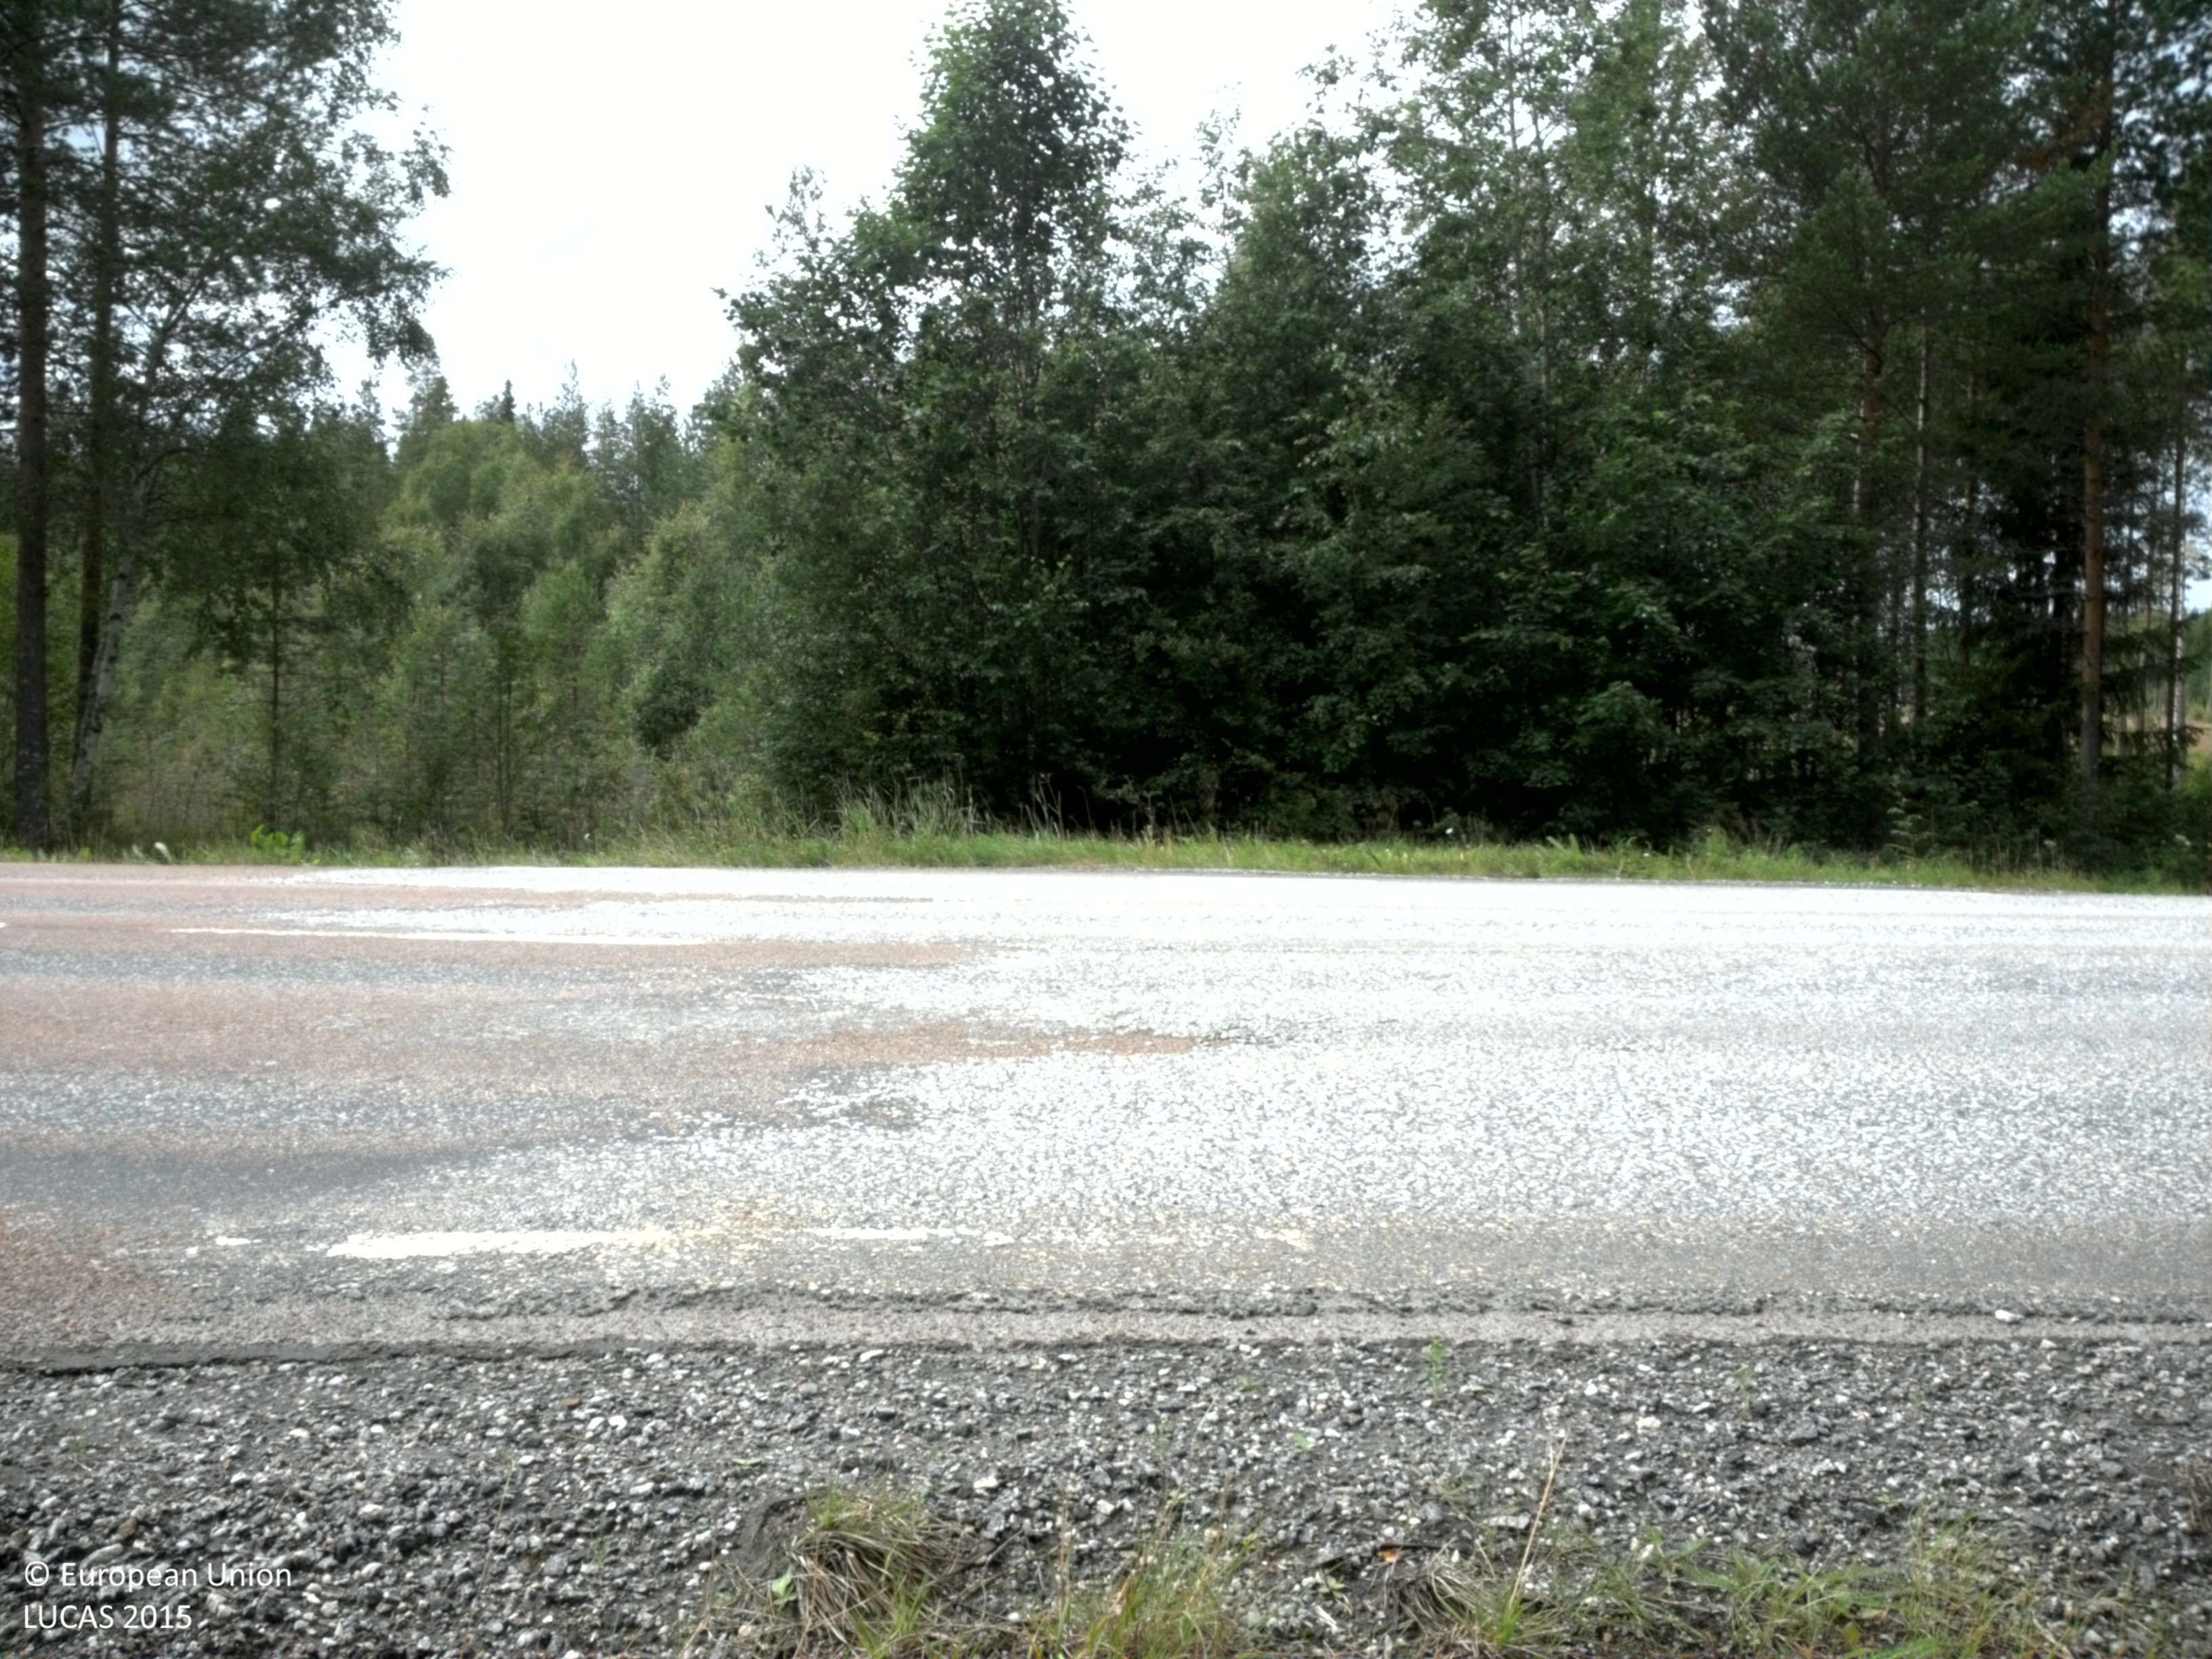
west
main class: Woodland
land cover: Spruce dominated mixed woodland
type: boreal forest
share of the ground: 50 - 75 %
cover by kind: coniferous forest trees 45 %, shrubs 25 %, broadleaved forest trees 15 %, herbaceous plants 10 %, lichens and mosses 5 %
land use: Forestry
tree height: > 5 m
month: August
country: SE
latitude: 64.6207
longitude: 20.9575
